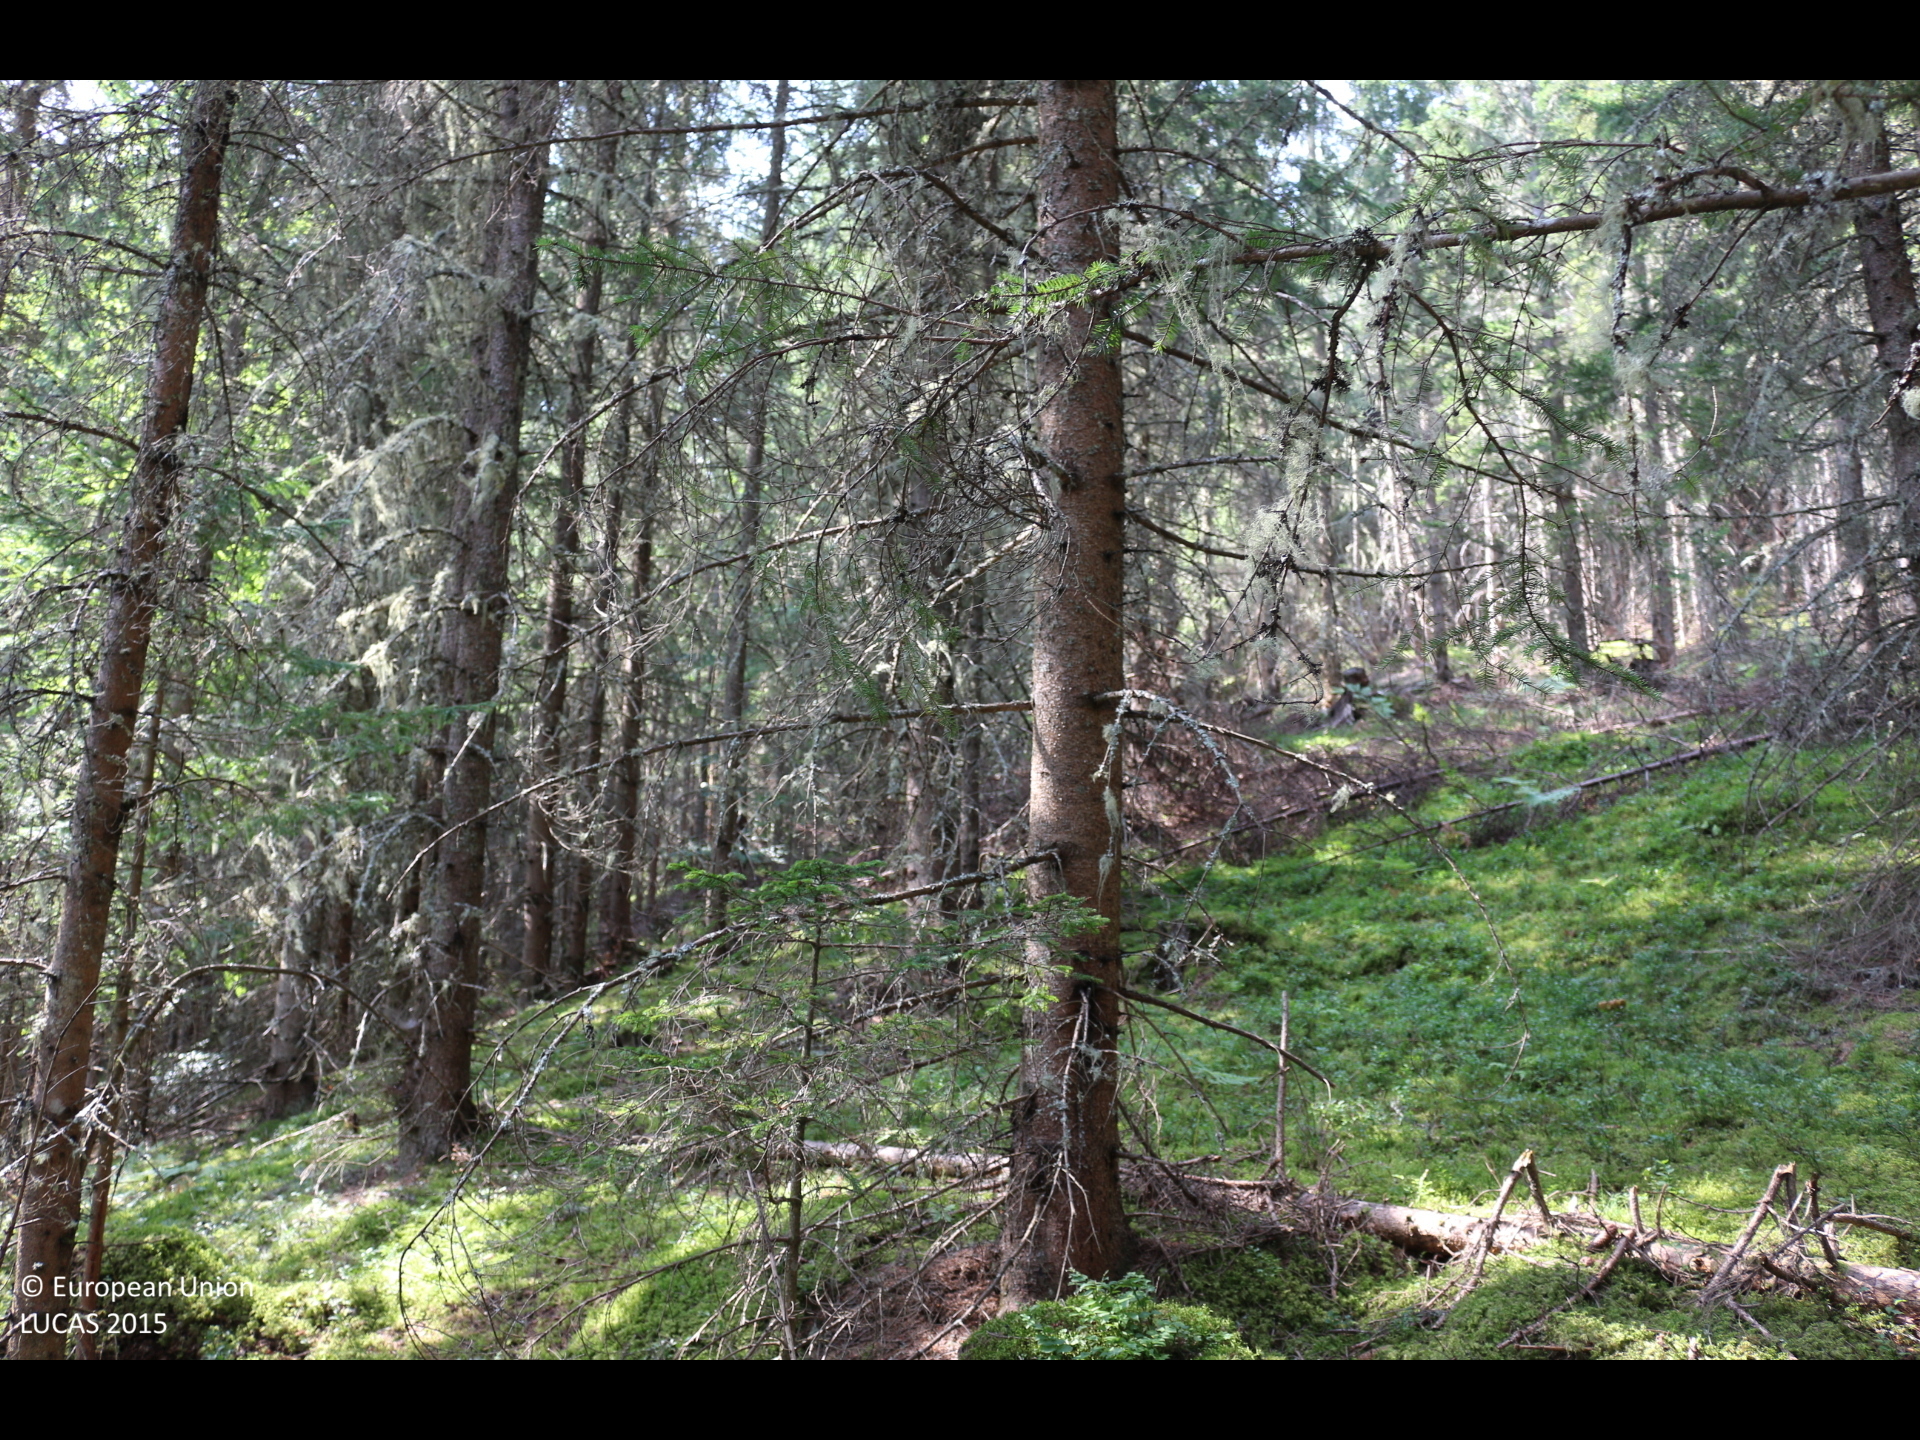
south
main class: Woodland
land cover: Spruce dominated coniferous woodland
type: alpine coniferous forest
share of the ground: > 75 %
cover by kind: coniferous forest trees 90 %, lichens and mosses 10 %
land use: Forestry
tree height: > 5 m
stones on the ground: < 10 %
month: August
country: AT
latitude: 46.9744
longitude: 14.1386
